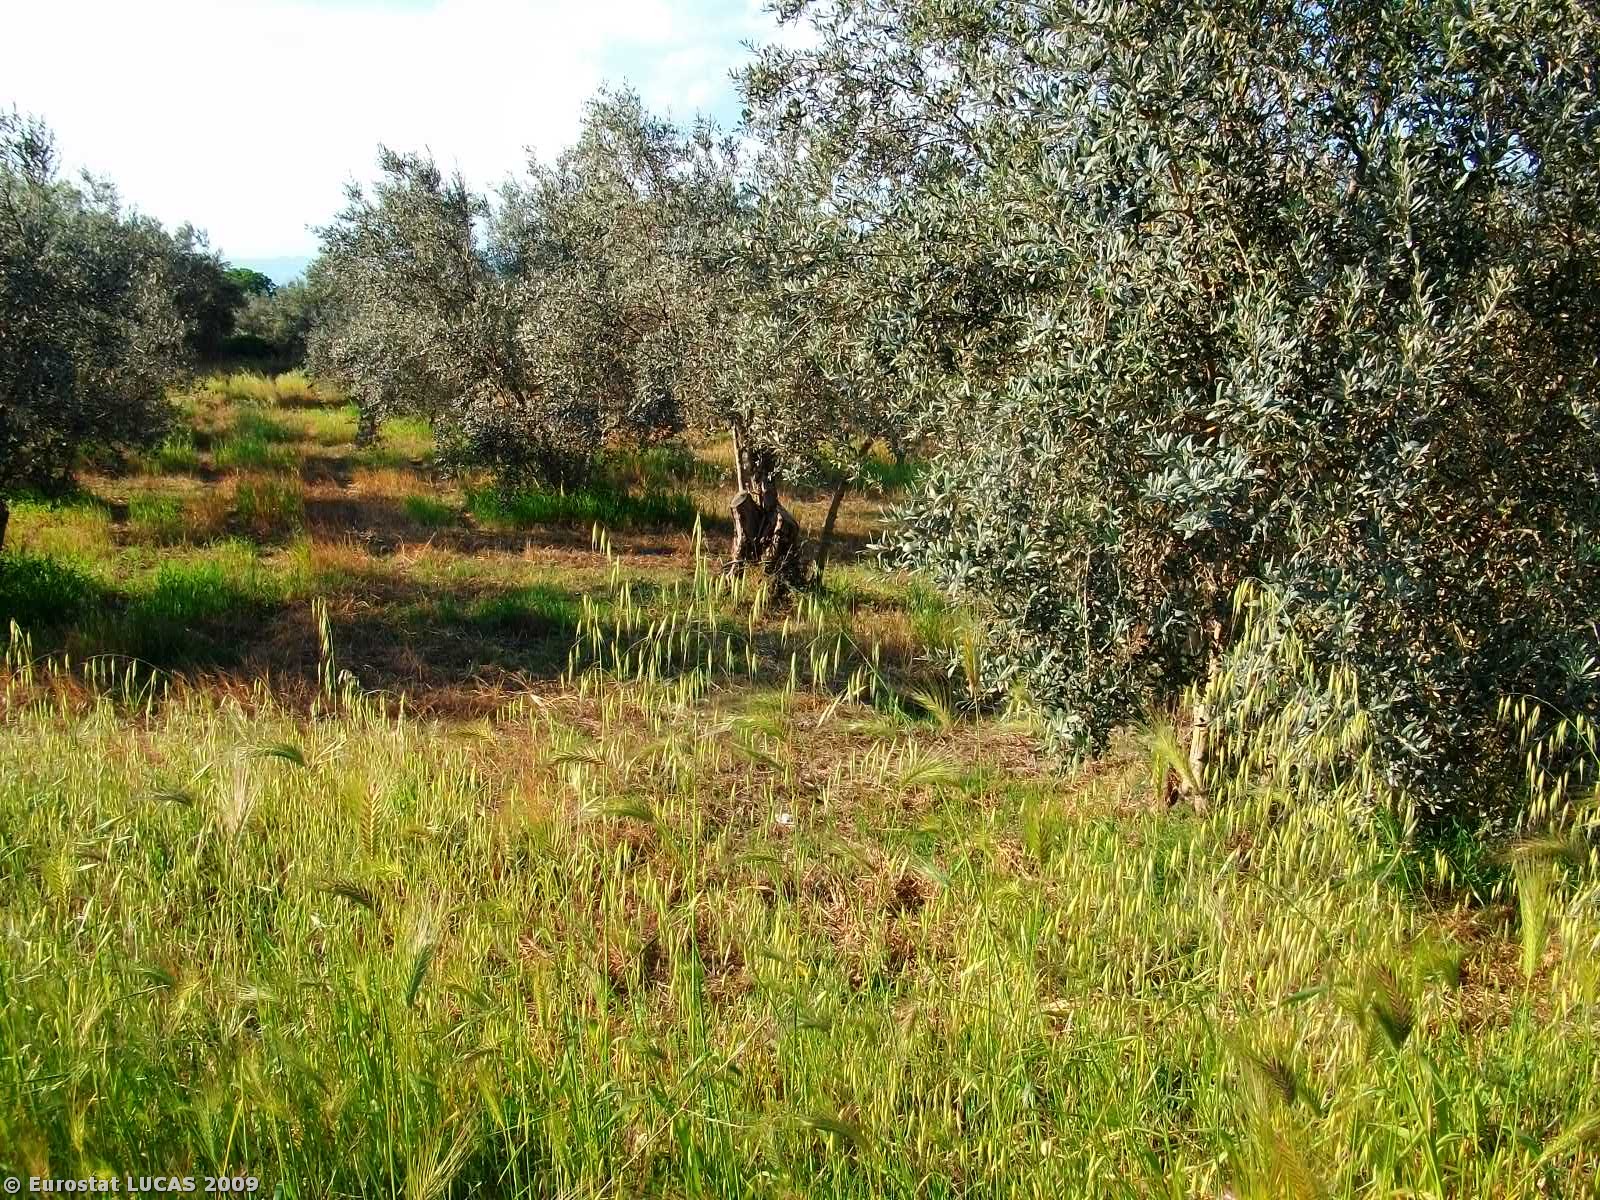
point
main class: Cropland
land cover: Olive groves
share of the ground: 50 - 75 %
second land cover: Grassland with sparse tree/shrub cover
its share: 50 - 75 %
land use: Agriculture (excluding fallow land and kitchen gardens)
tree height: < 5 m
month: May
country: GR
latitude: 38.8151
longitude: 22.4292
